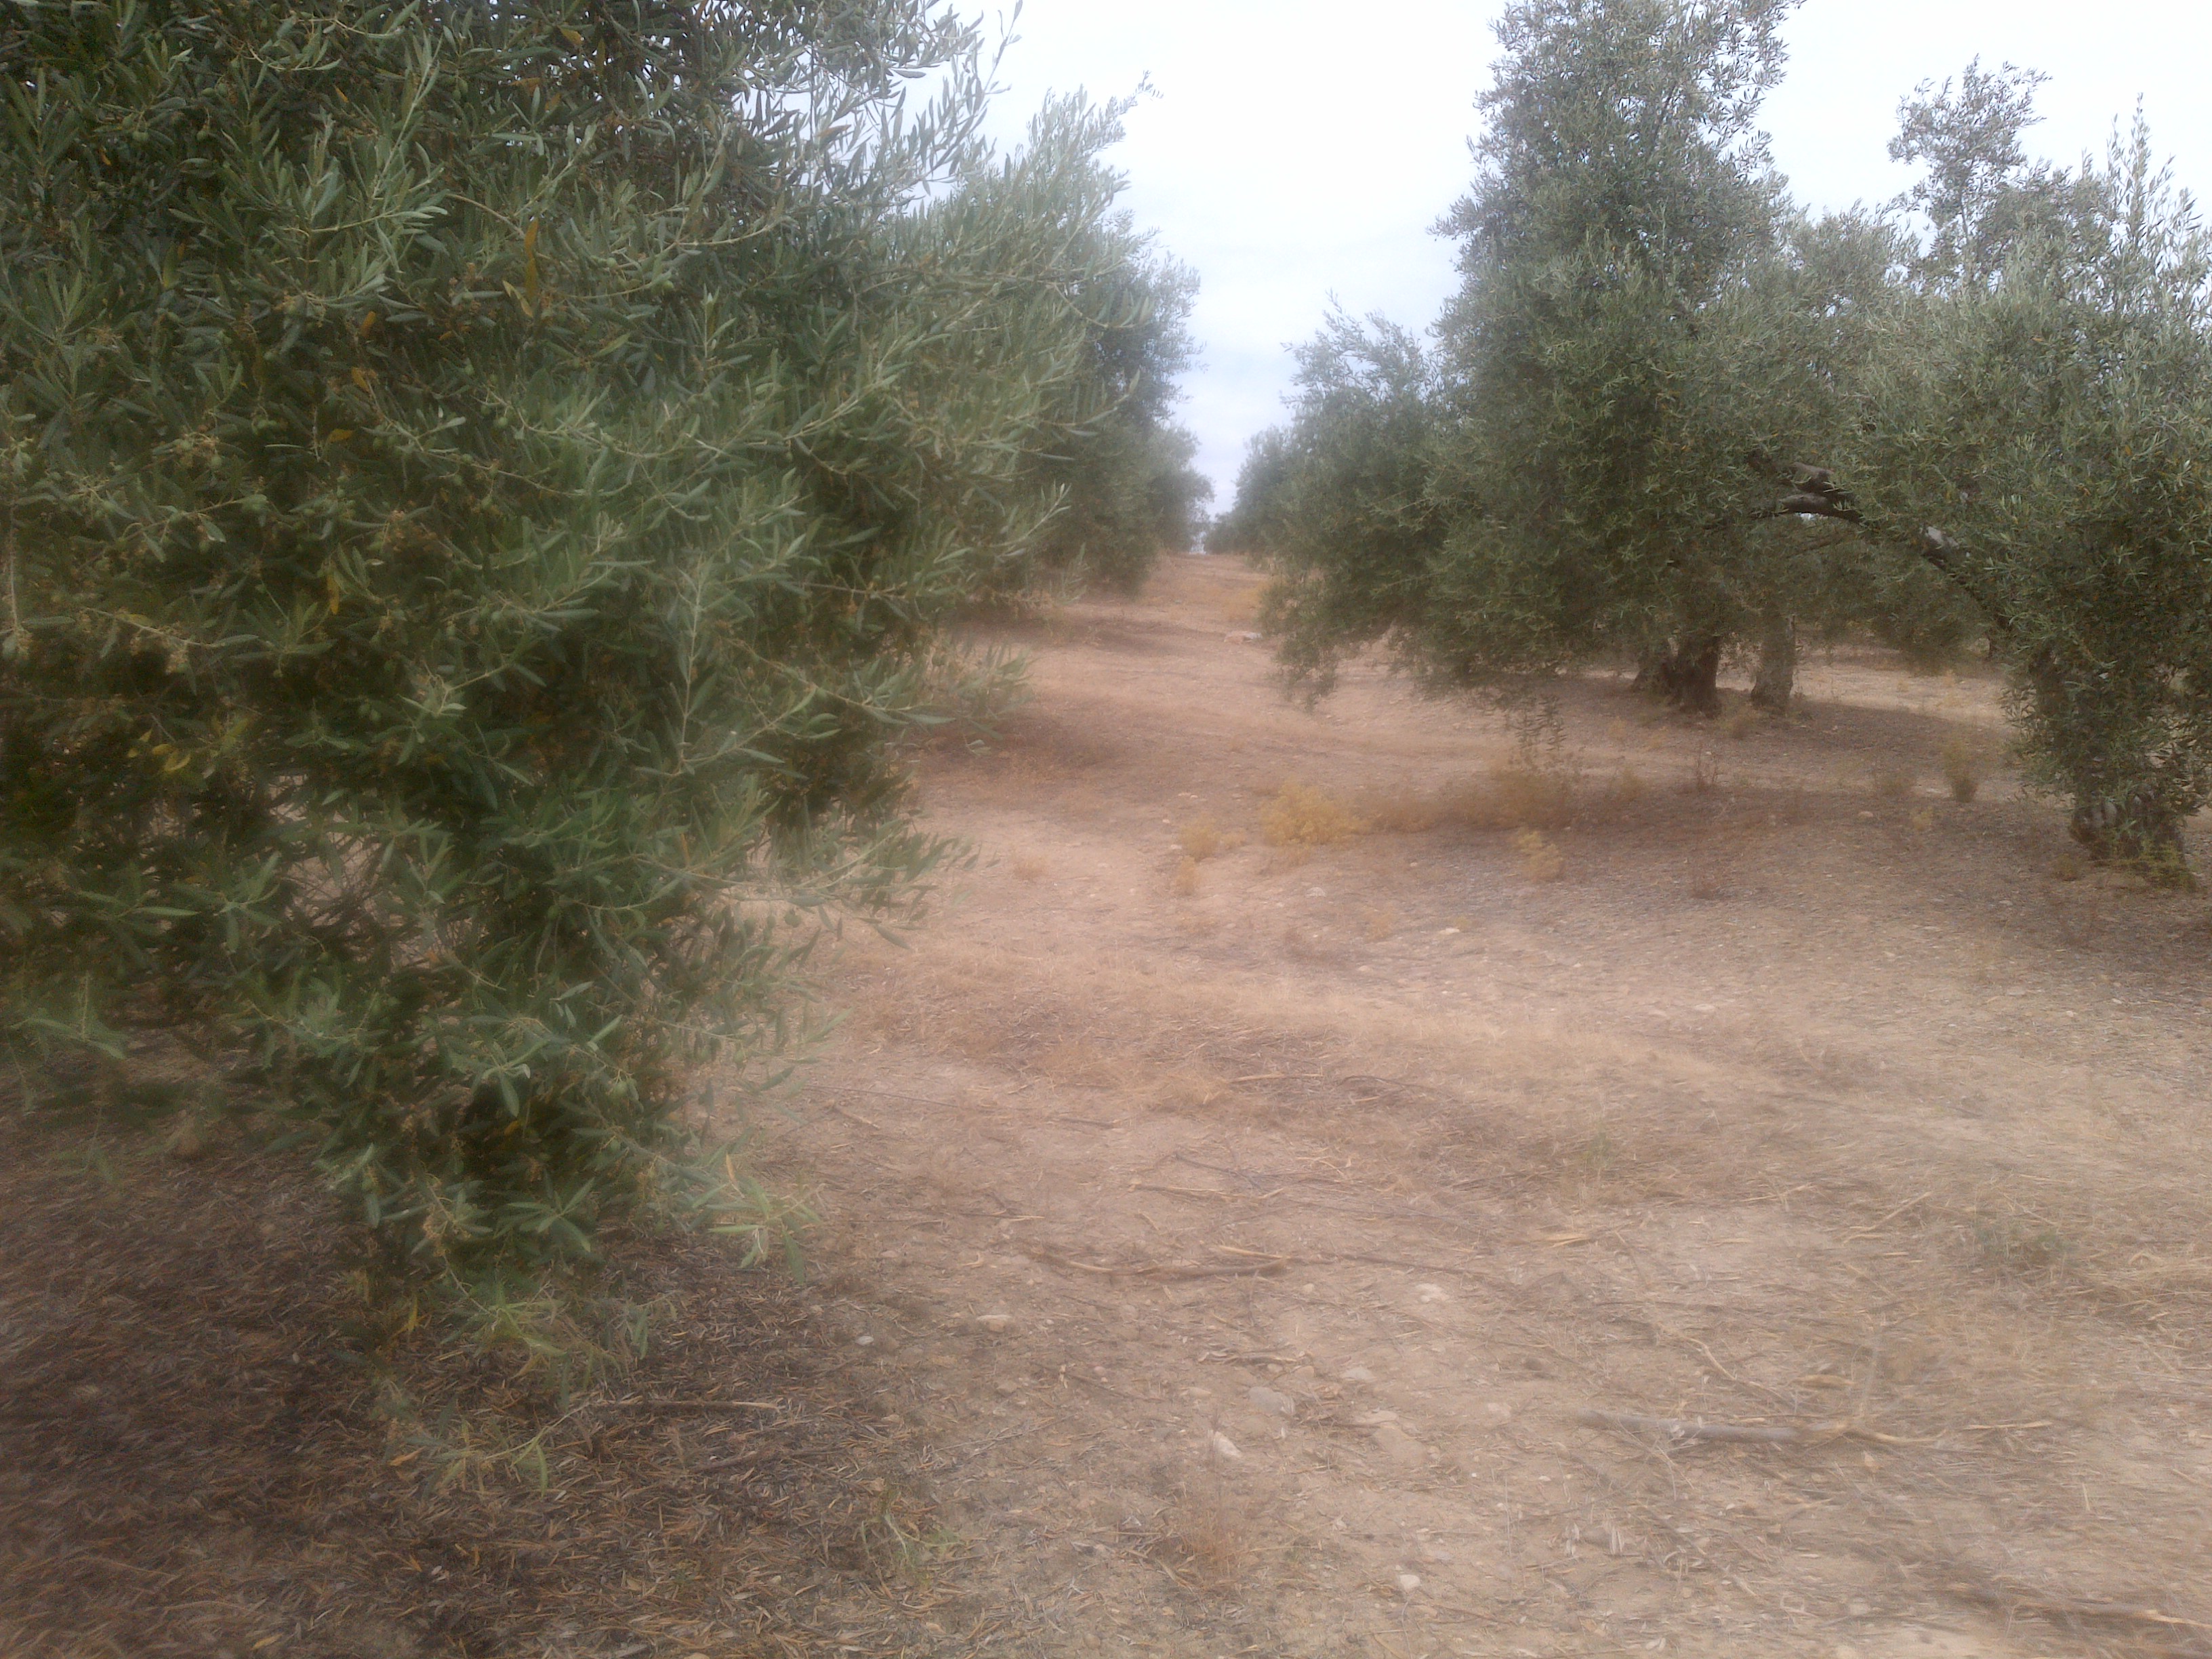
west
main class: Cropland
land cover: Olive groves
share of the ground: 50 - 75 %
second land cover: Spontaneously vegetated surfaces
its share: 10 - 25 %
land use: Agriculture (excluding fallow land and kitchen gardens)
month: June
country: ES
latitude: 37.9747
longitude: -4.4811
